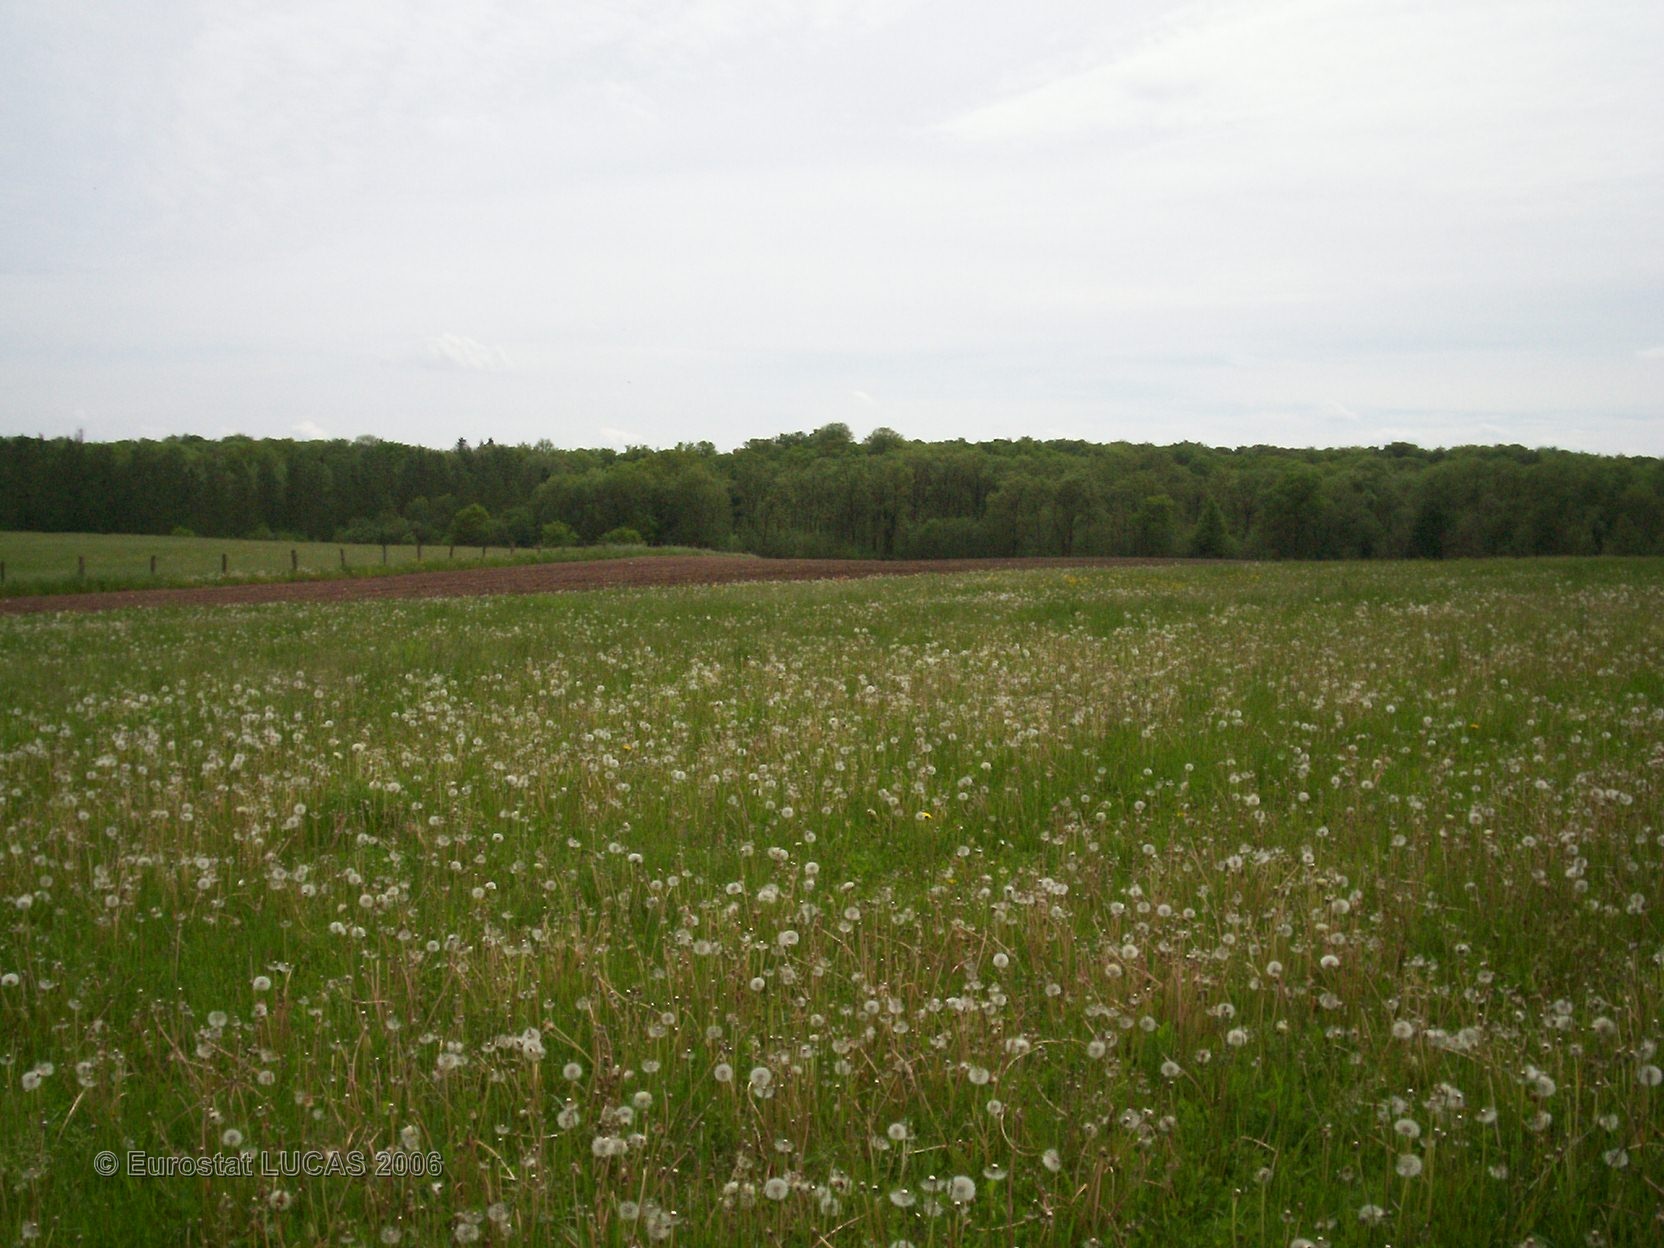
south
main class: Grassland
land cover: Grassland without tree/shrub cover
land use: Agriculture (excluding fallow land and kitchen gardens)
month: May
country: FR
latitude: 48.4398
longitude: 6.5535
